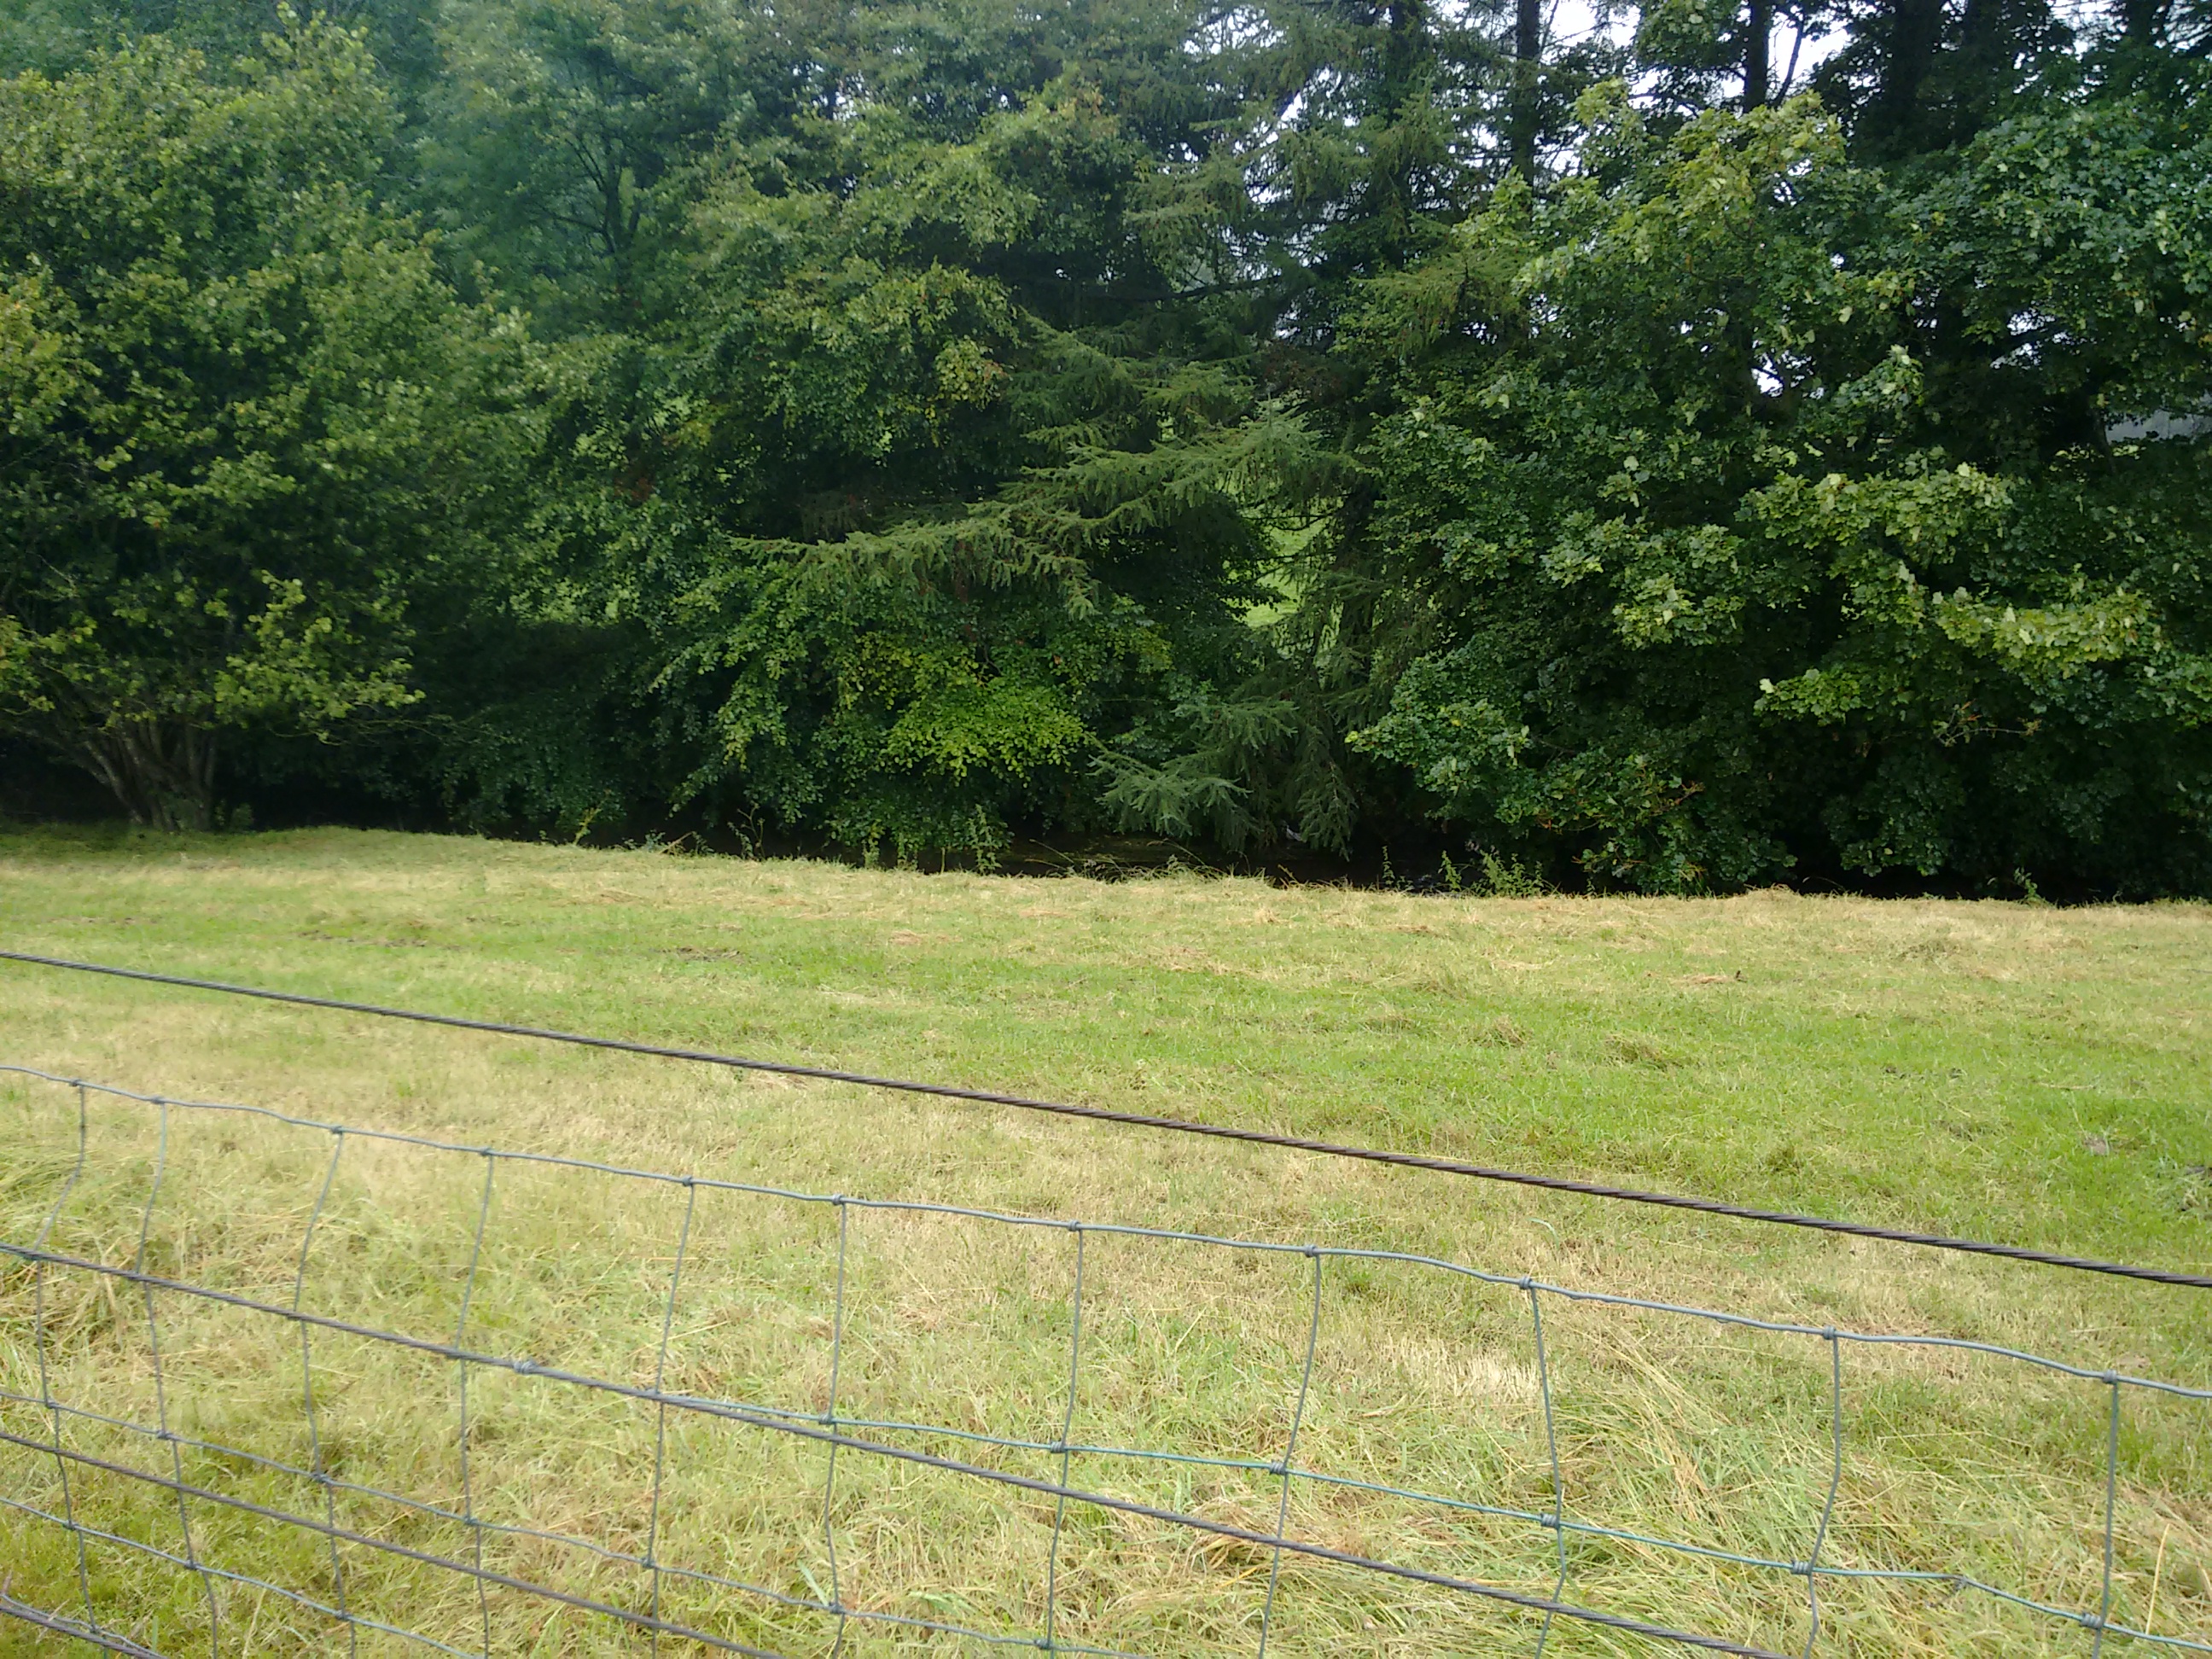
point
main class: Grassland
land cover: Grassland without tree/shrub cover
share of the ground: > 75 %
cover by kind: herbaceous plants 100 %
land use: Agriculture (excluding fallow land and kitchen gardens)
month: August
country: GB
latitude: 54.8701
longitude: -6.6289
